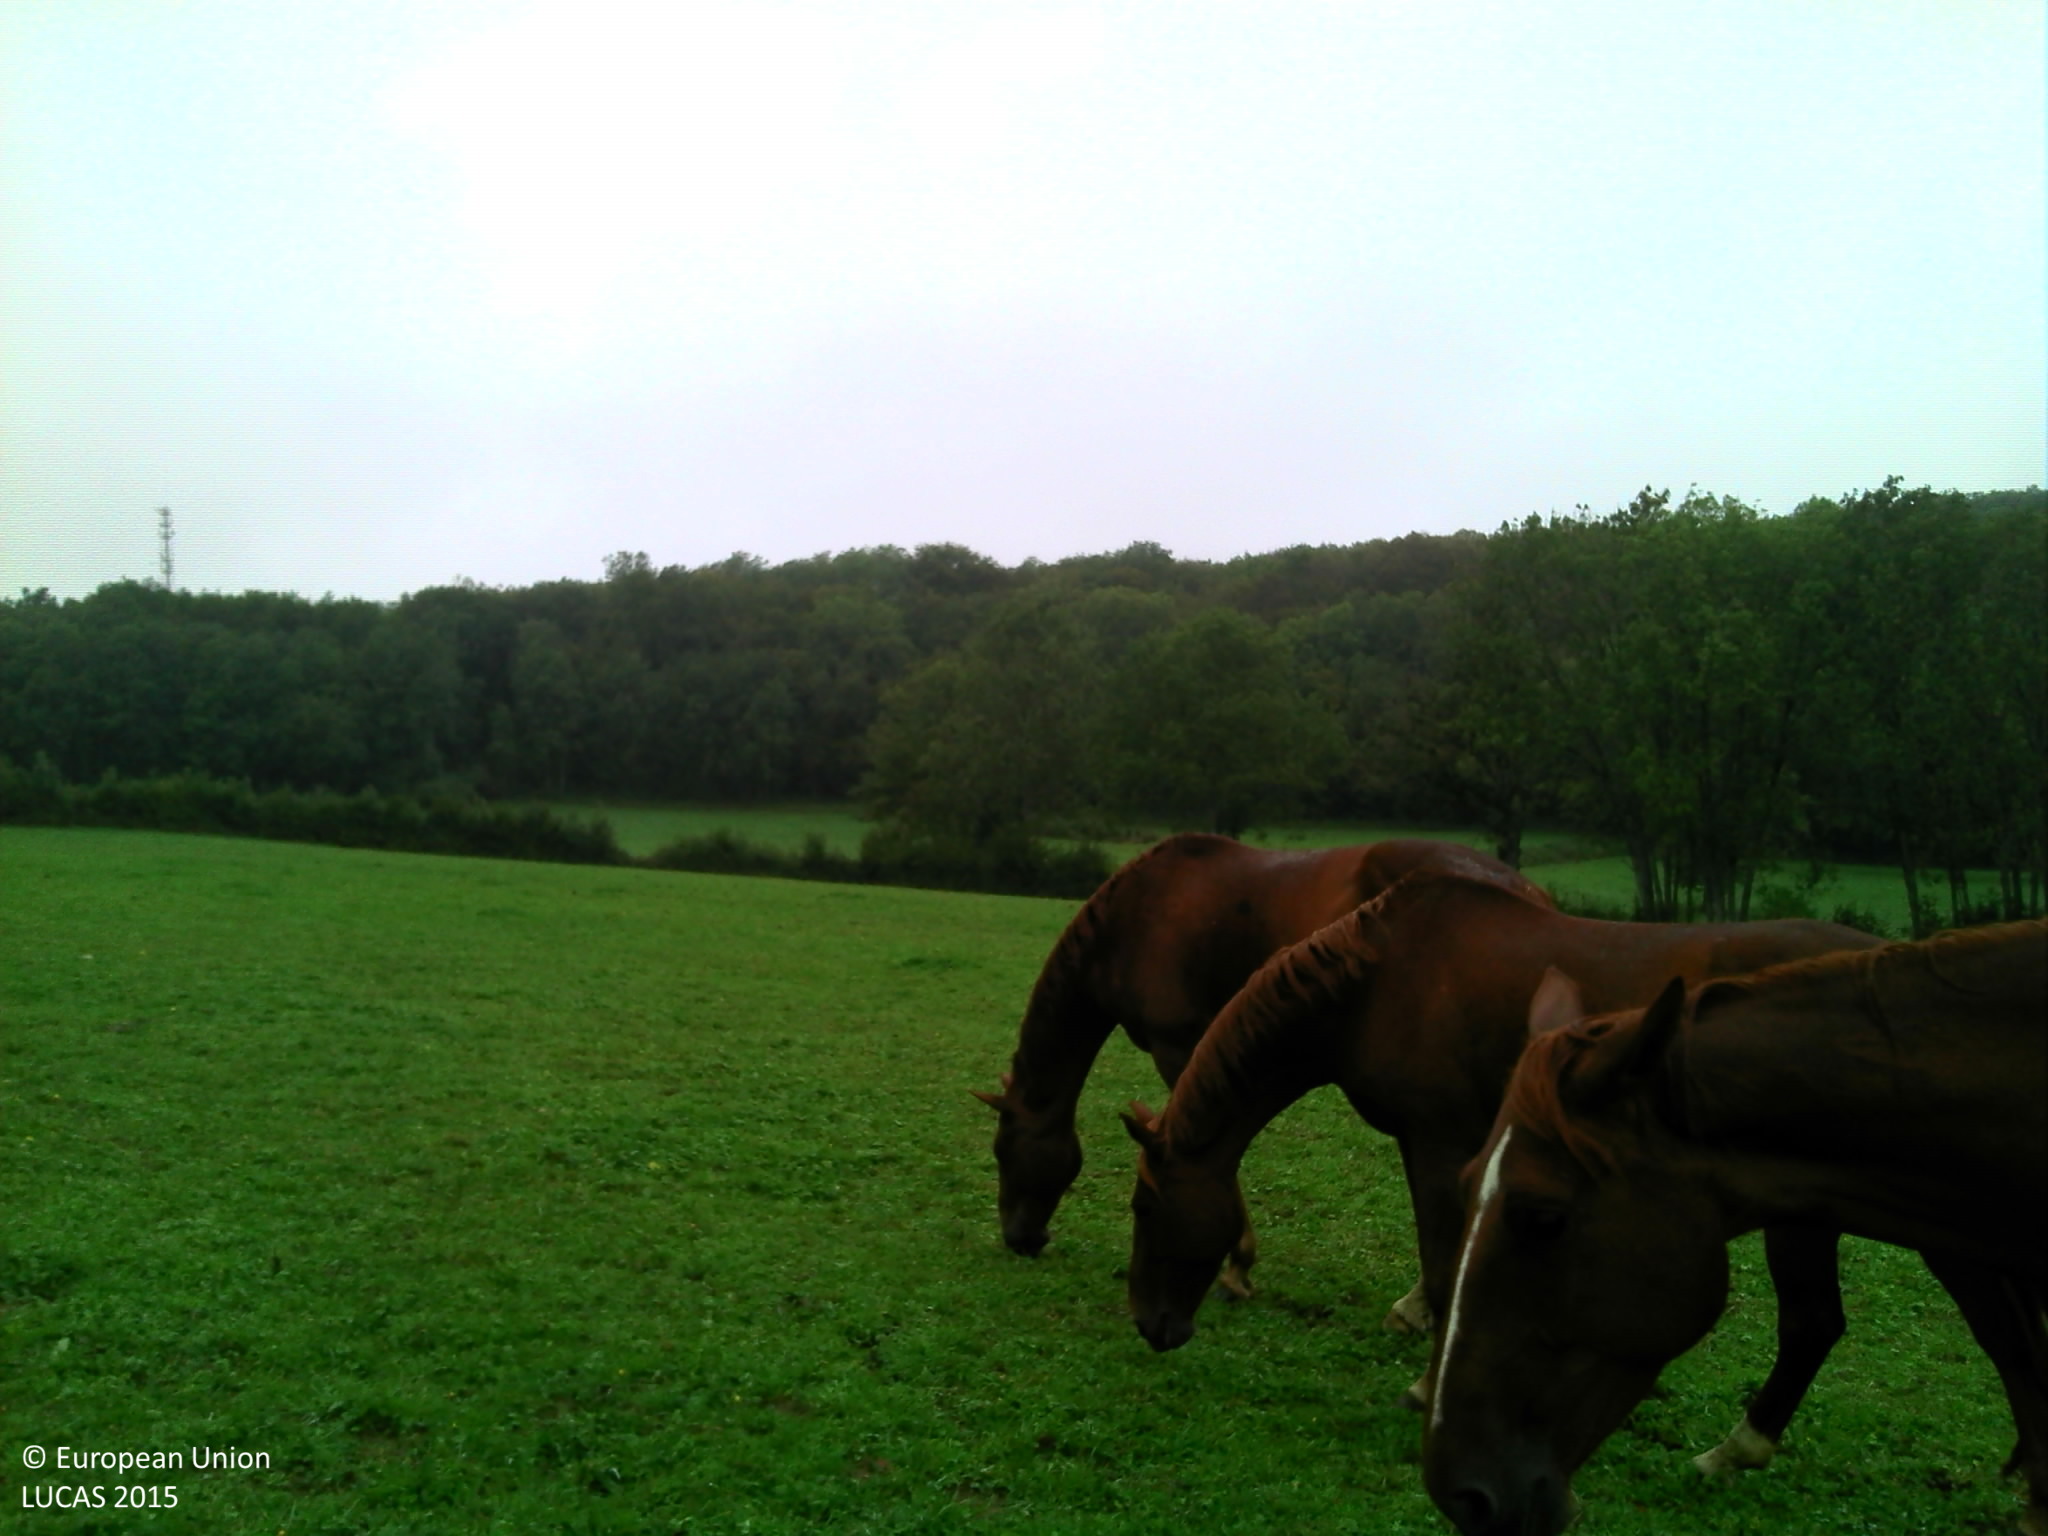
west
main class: Grassland
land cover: Grassland without tree/shrub cover
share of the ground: > 75 %
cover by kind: herbaceous plants 100 %
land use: Agriculture (excluding fallow land and kitchen gardens)
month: September
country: FR
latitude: 47.0702
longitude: 4.7463
